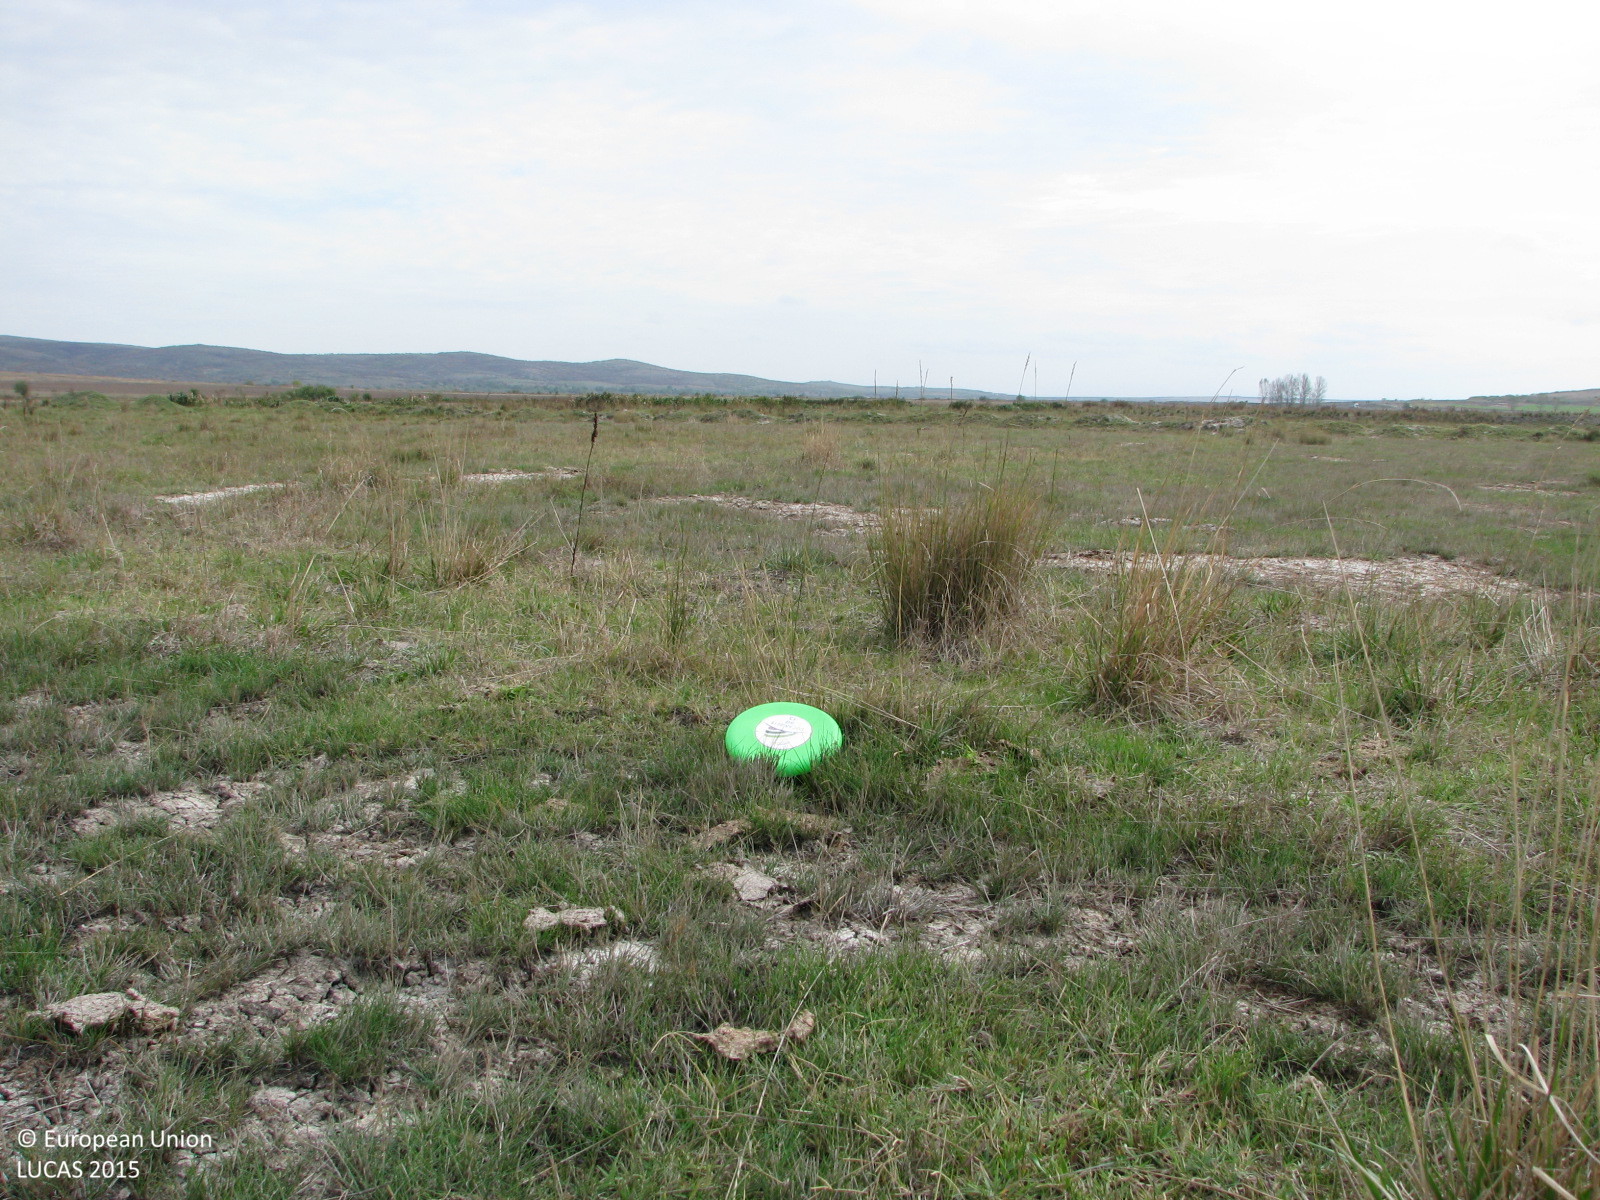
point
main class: Grassland
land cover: Grassland without tree/shrub cover
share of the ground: > 75 %
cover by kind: herbaceous plants 95 %, unconsolidated bare surface 5 %
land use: Agriculture (excluding fallow land and kitchen gardens)
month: October
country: BG
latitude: 42.5024
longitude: 26.2842
